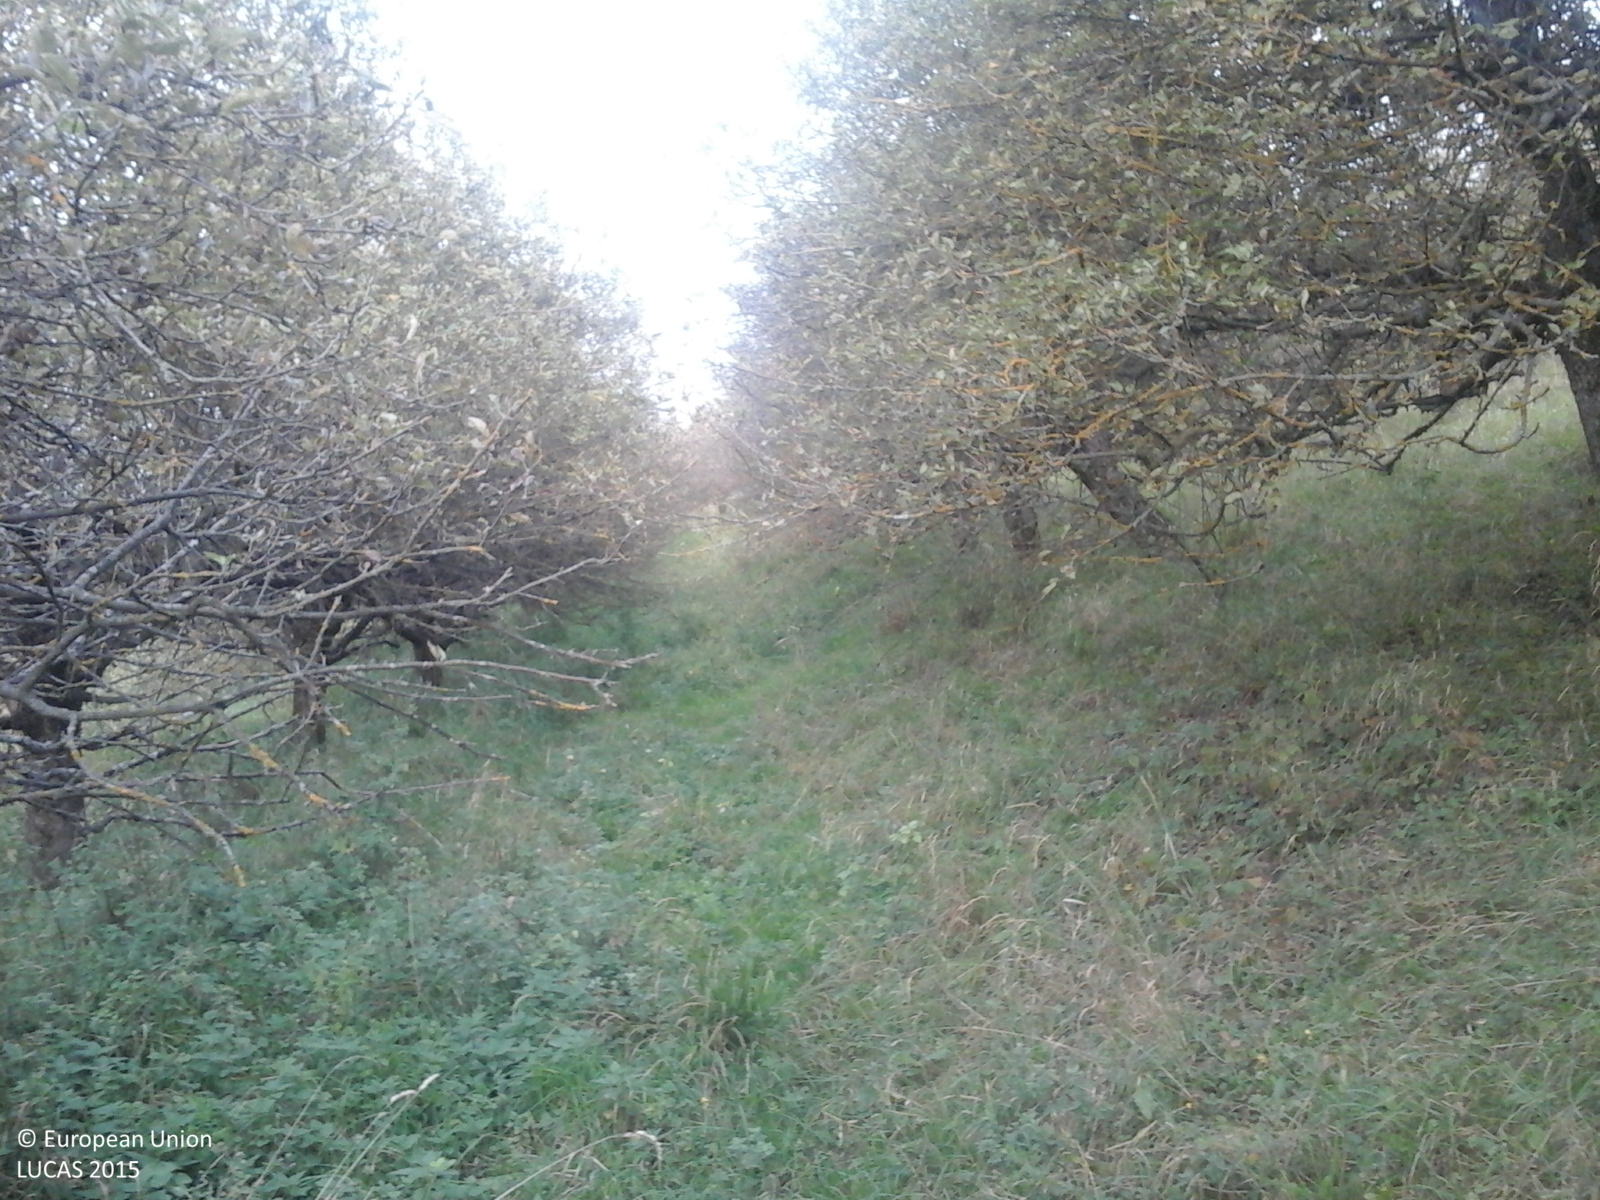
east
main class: Cropland
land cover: Apple fruit
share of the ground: > 75 %
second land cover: Grassland without tree/shrub cover
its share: > 75 %
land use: Agriculture (excluding fallow land and kitchen gardens)
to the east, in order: Apple fruit; Grassland without tree/shrub cover; Tracks
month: September
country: RO
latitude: 46.7351
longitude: 23.6160
